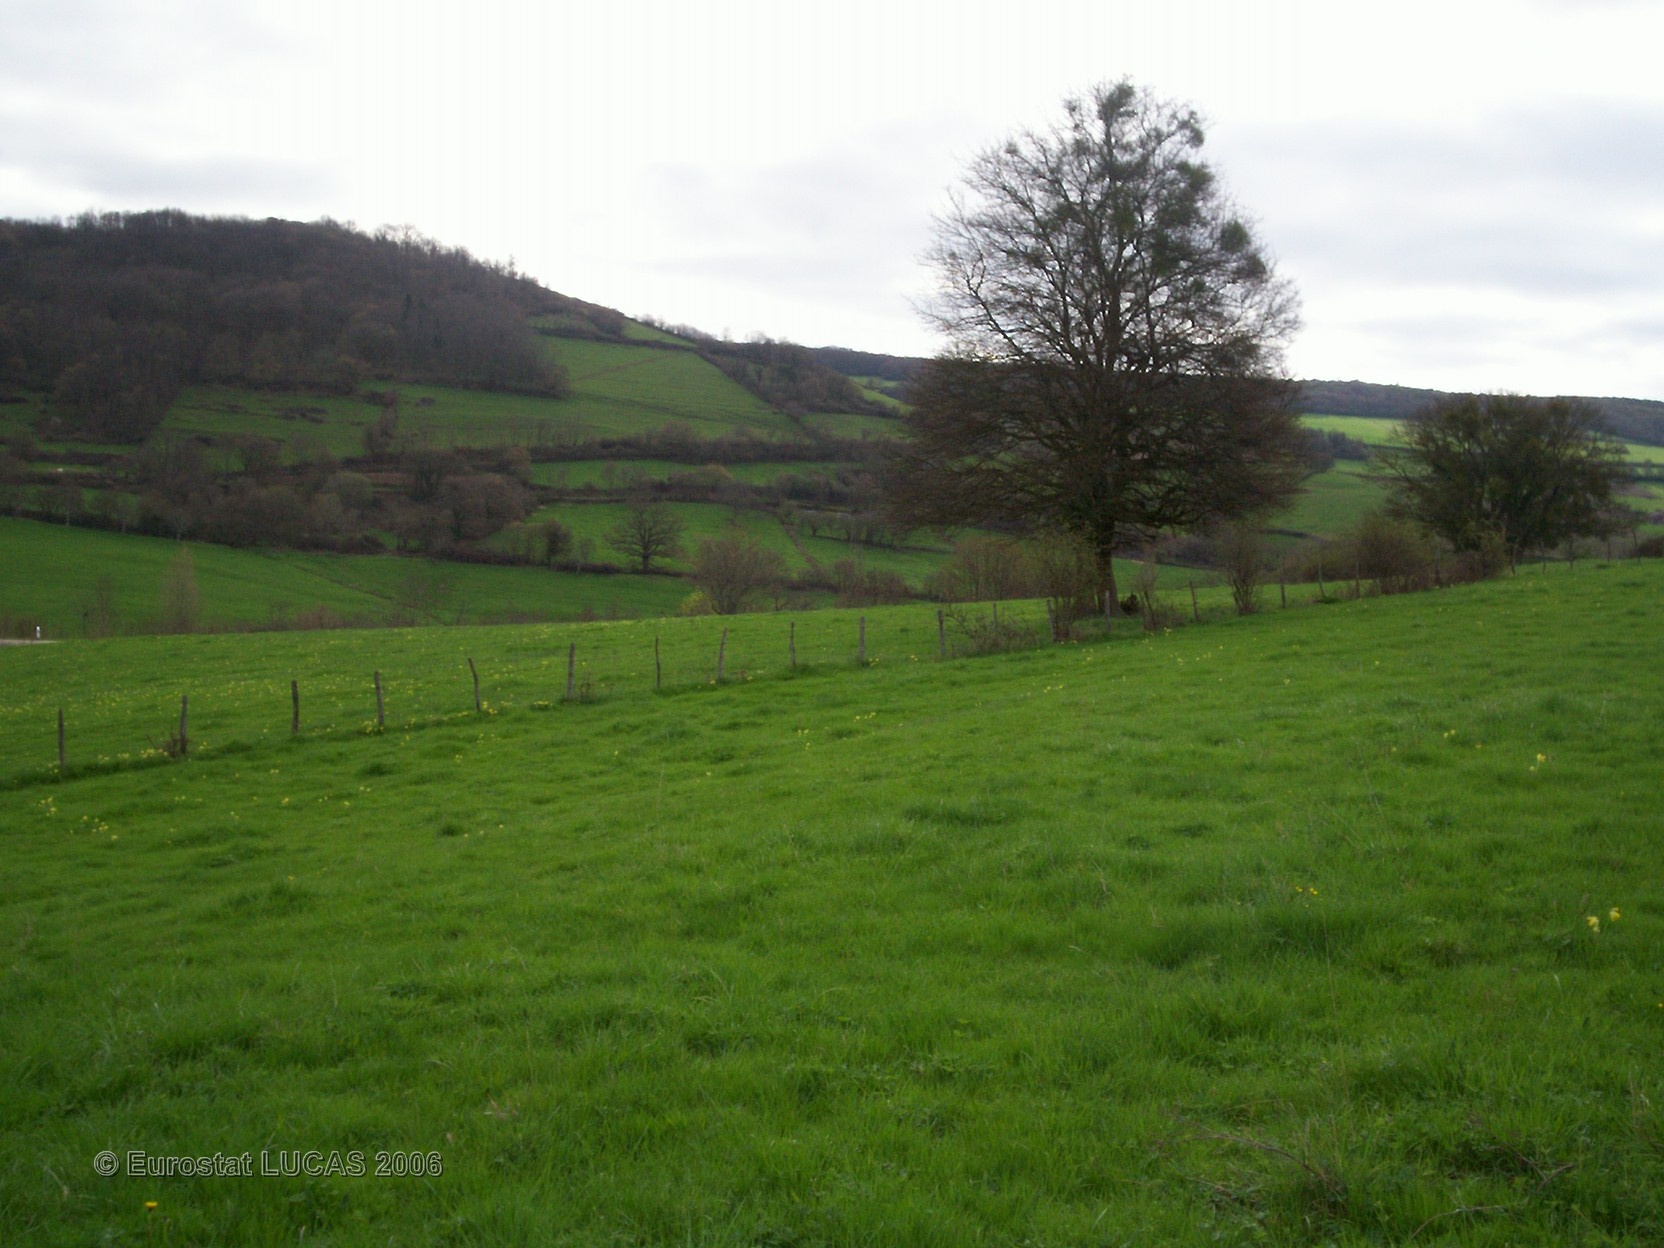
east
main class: Grassland
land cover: Grassland without tree/shrub cover
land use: Agriculture (excluding fallow land and kitchen gardens)
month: April
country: FR
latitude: 46.3815
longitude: 4.6841
